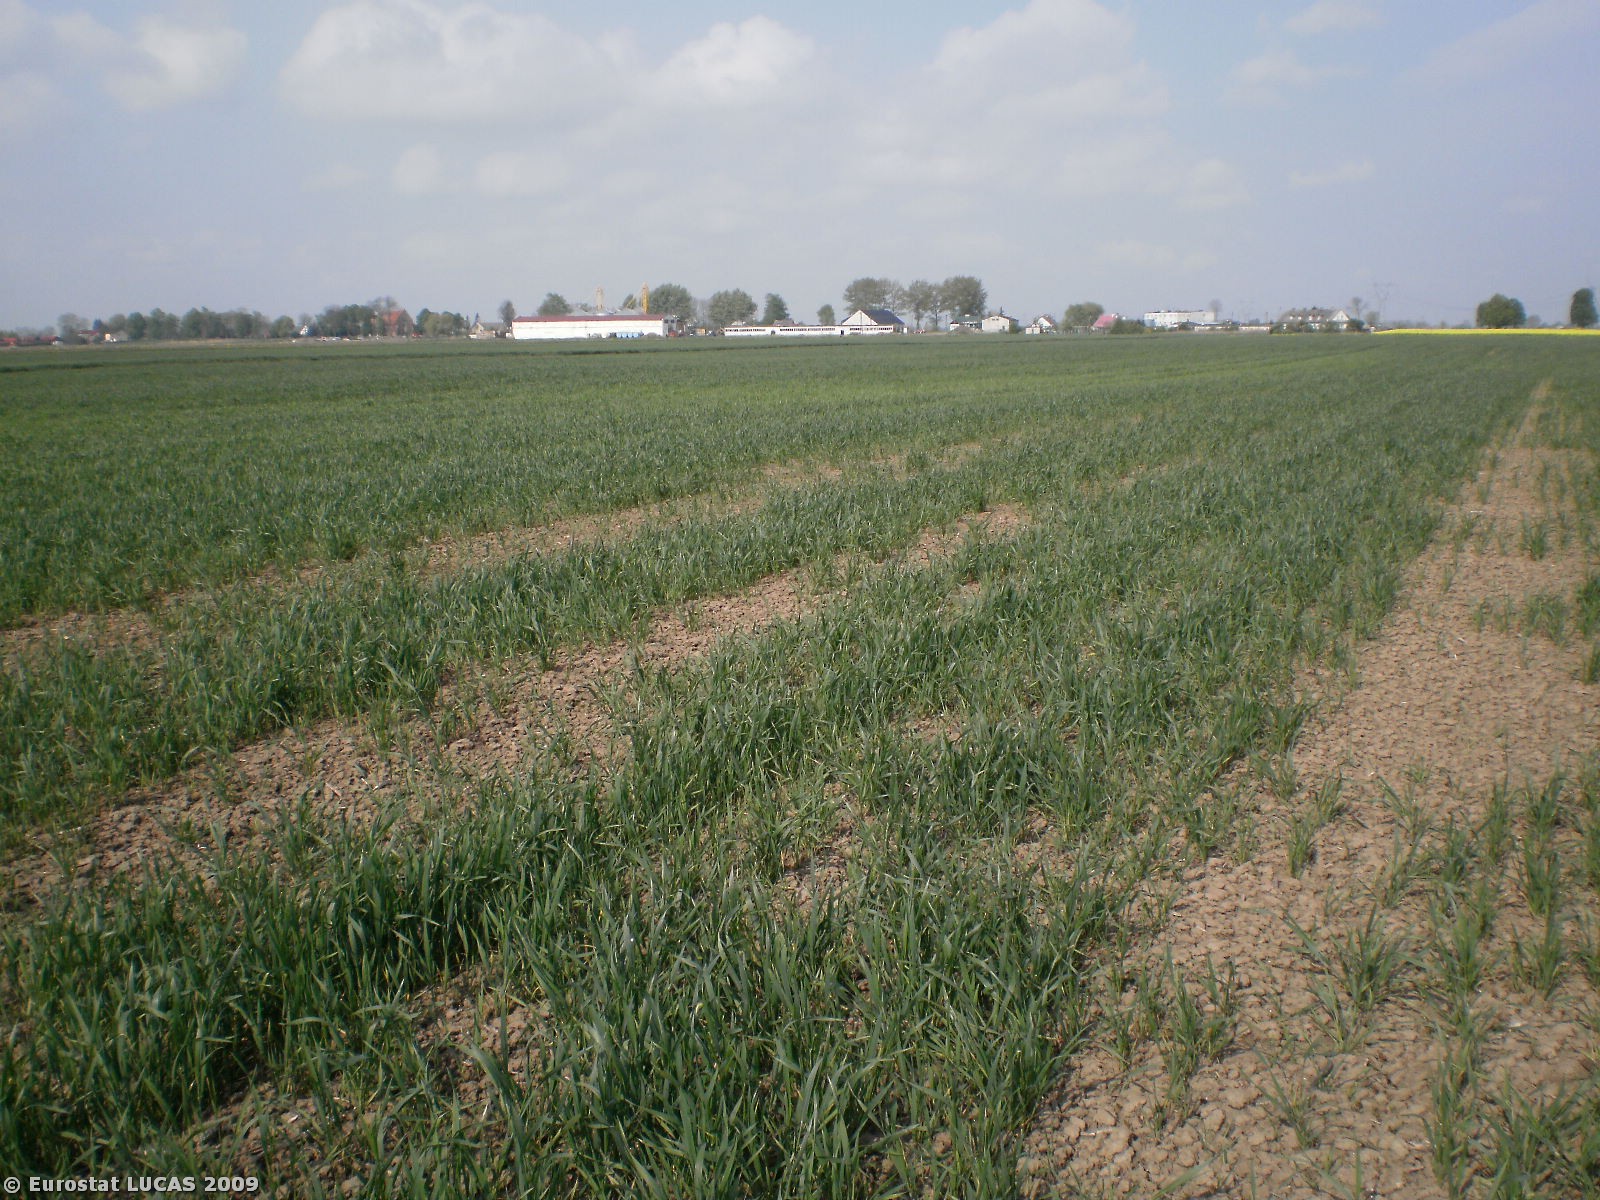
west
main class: Cropland
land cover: Common wheat
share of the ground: > 75 %
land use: Agriculture (excluding fallow land and kitchen gardens)
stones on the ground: < 10 %
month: May
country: PL
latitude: 54.2603
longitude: 19.0019
